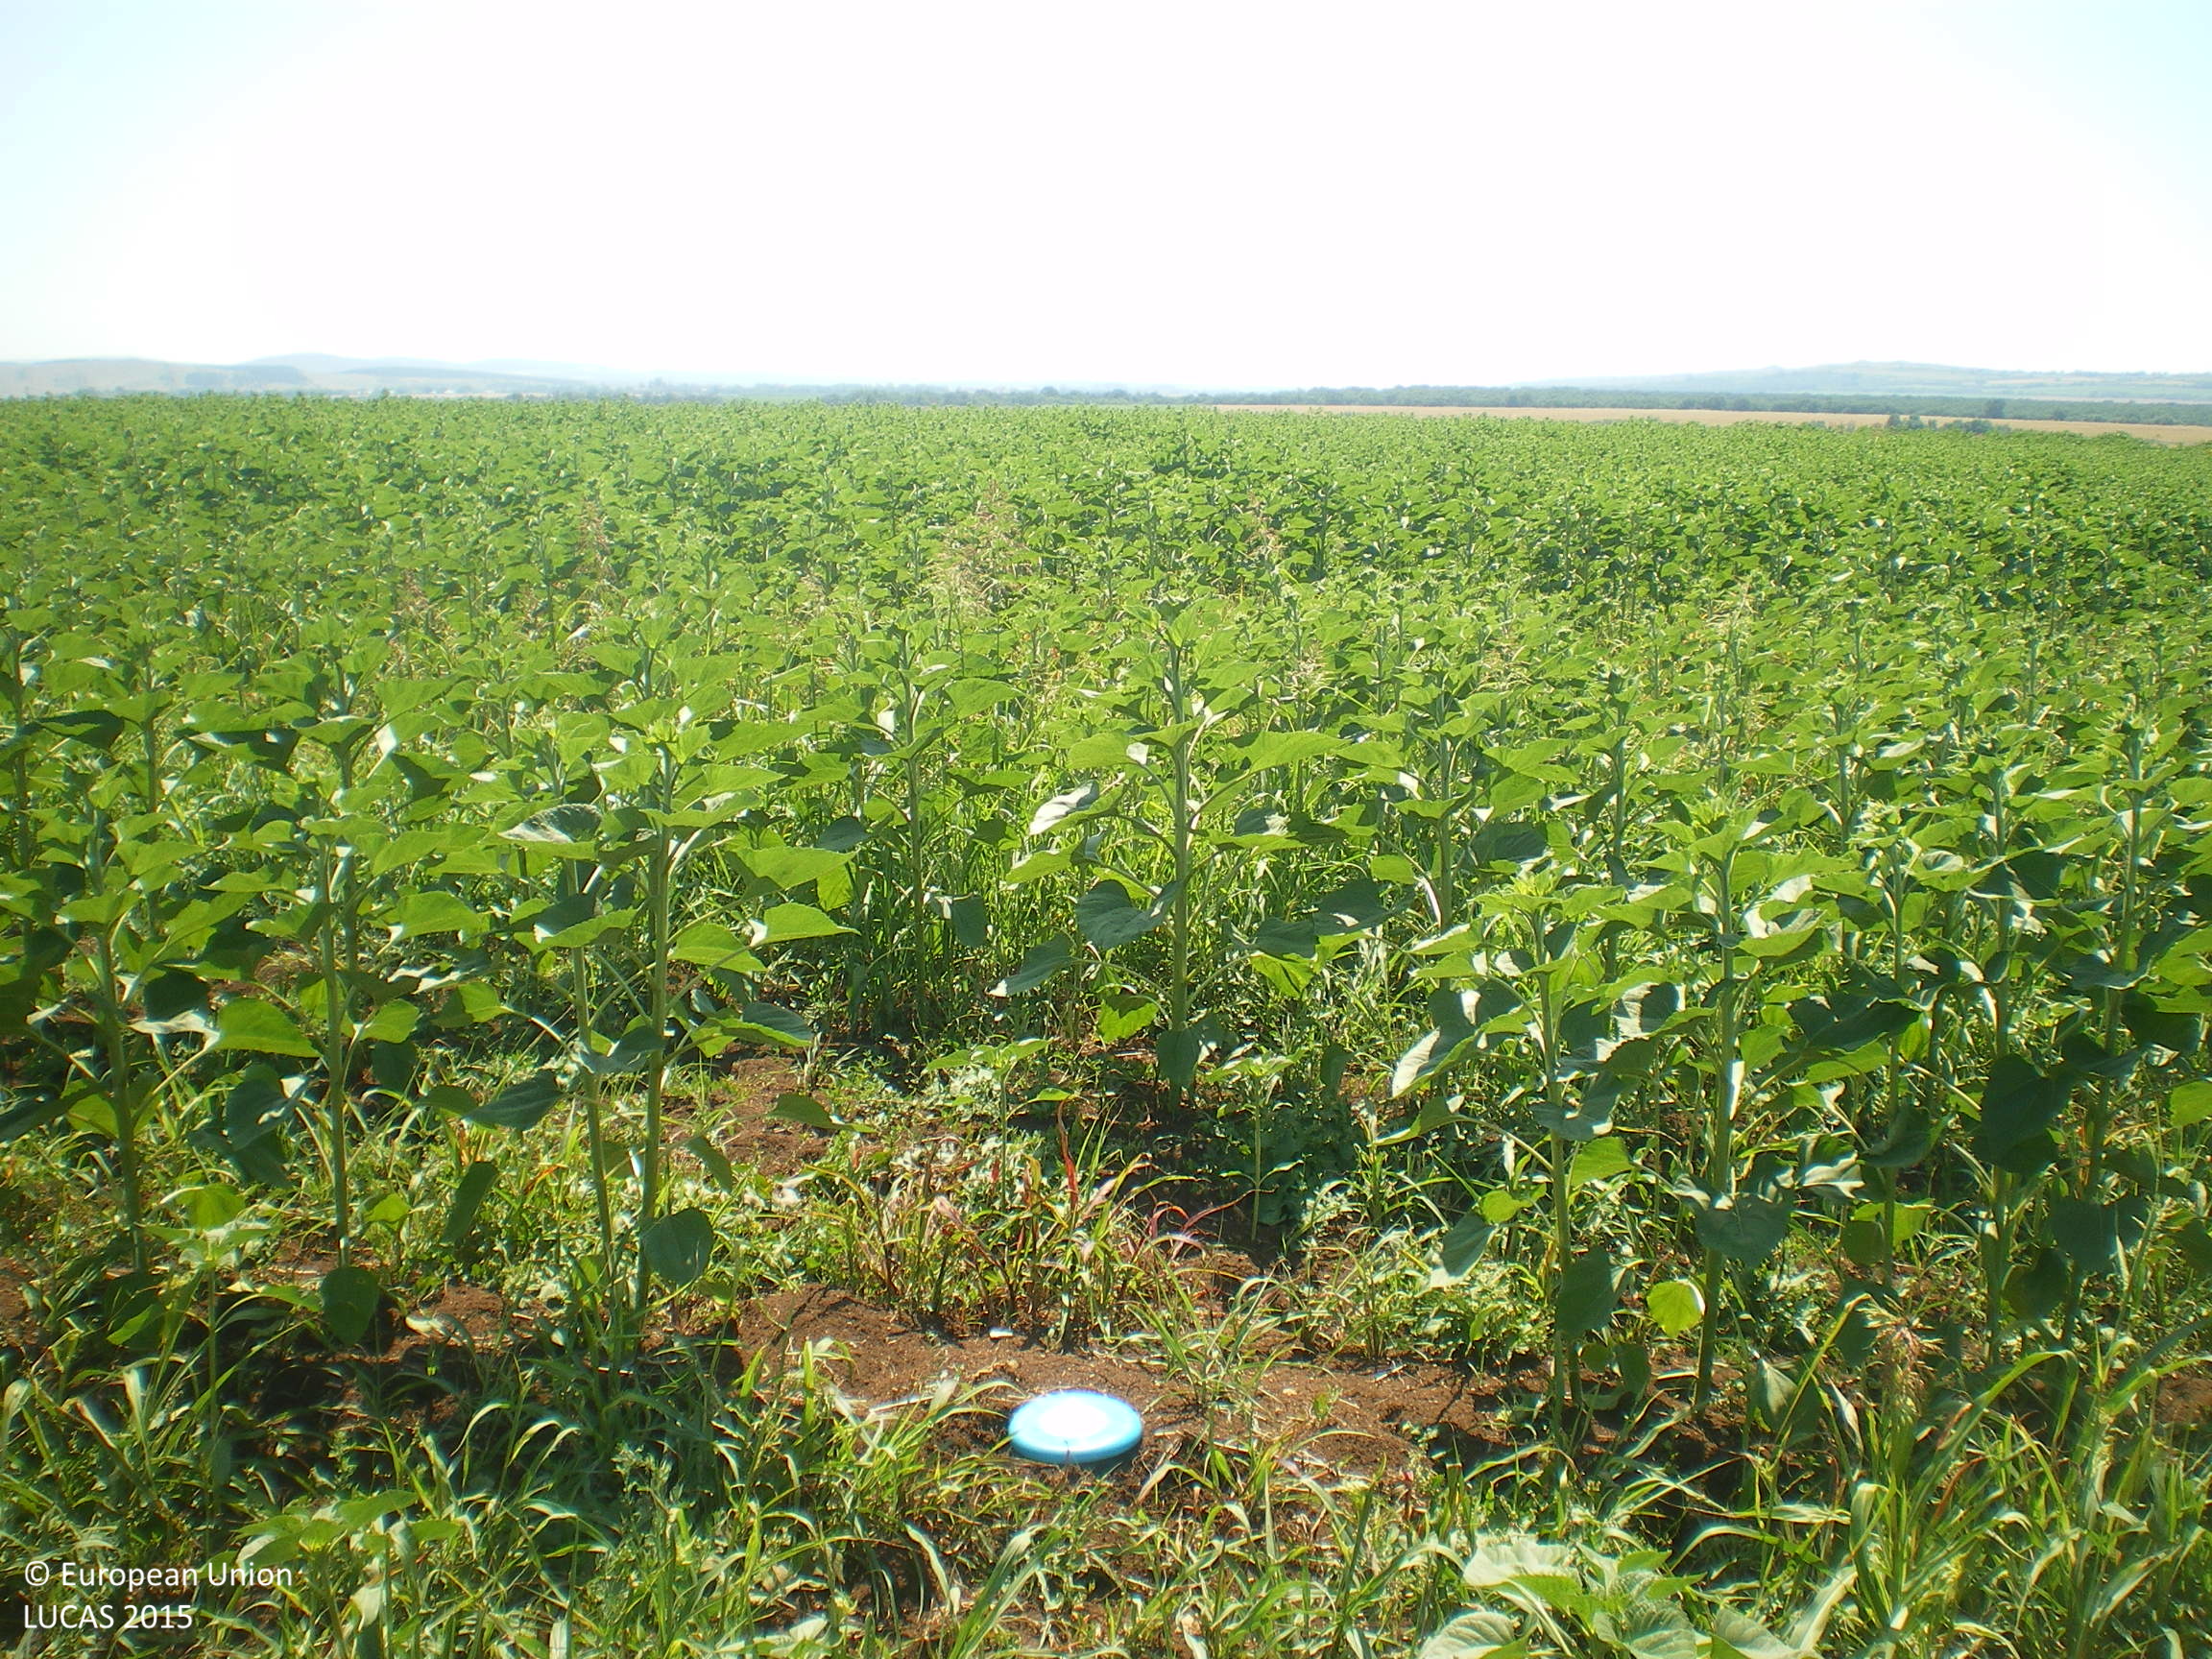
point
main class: Cropland
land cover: Sunflower
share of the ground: 50 - 75 %
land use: Agriculture (excluding fallow land and kitchen gardens)
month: June
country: BG
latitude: 42.3115
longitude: 25.1657
